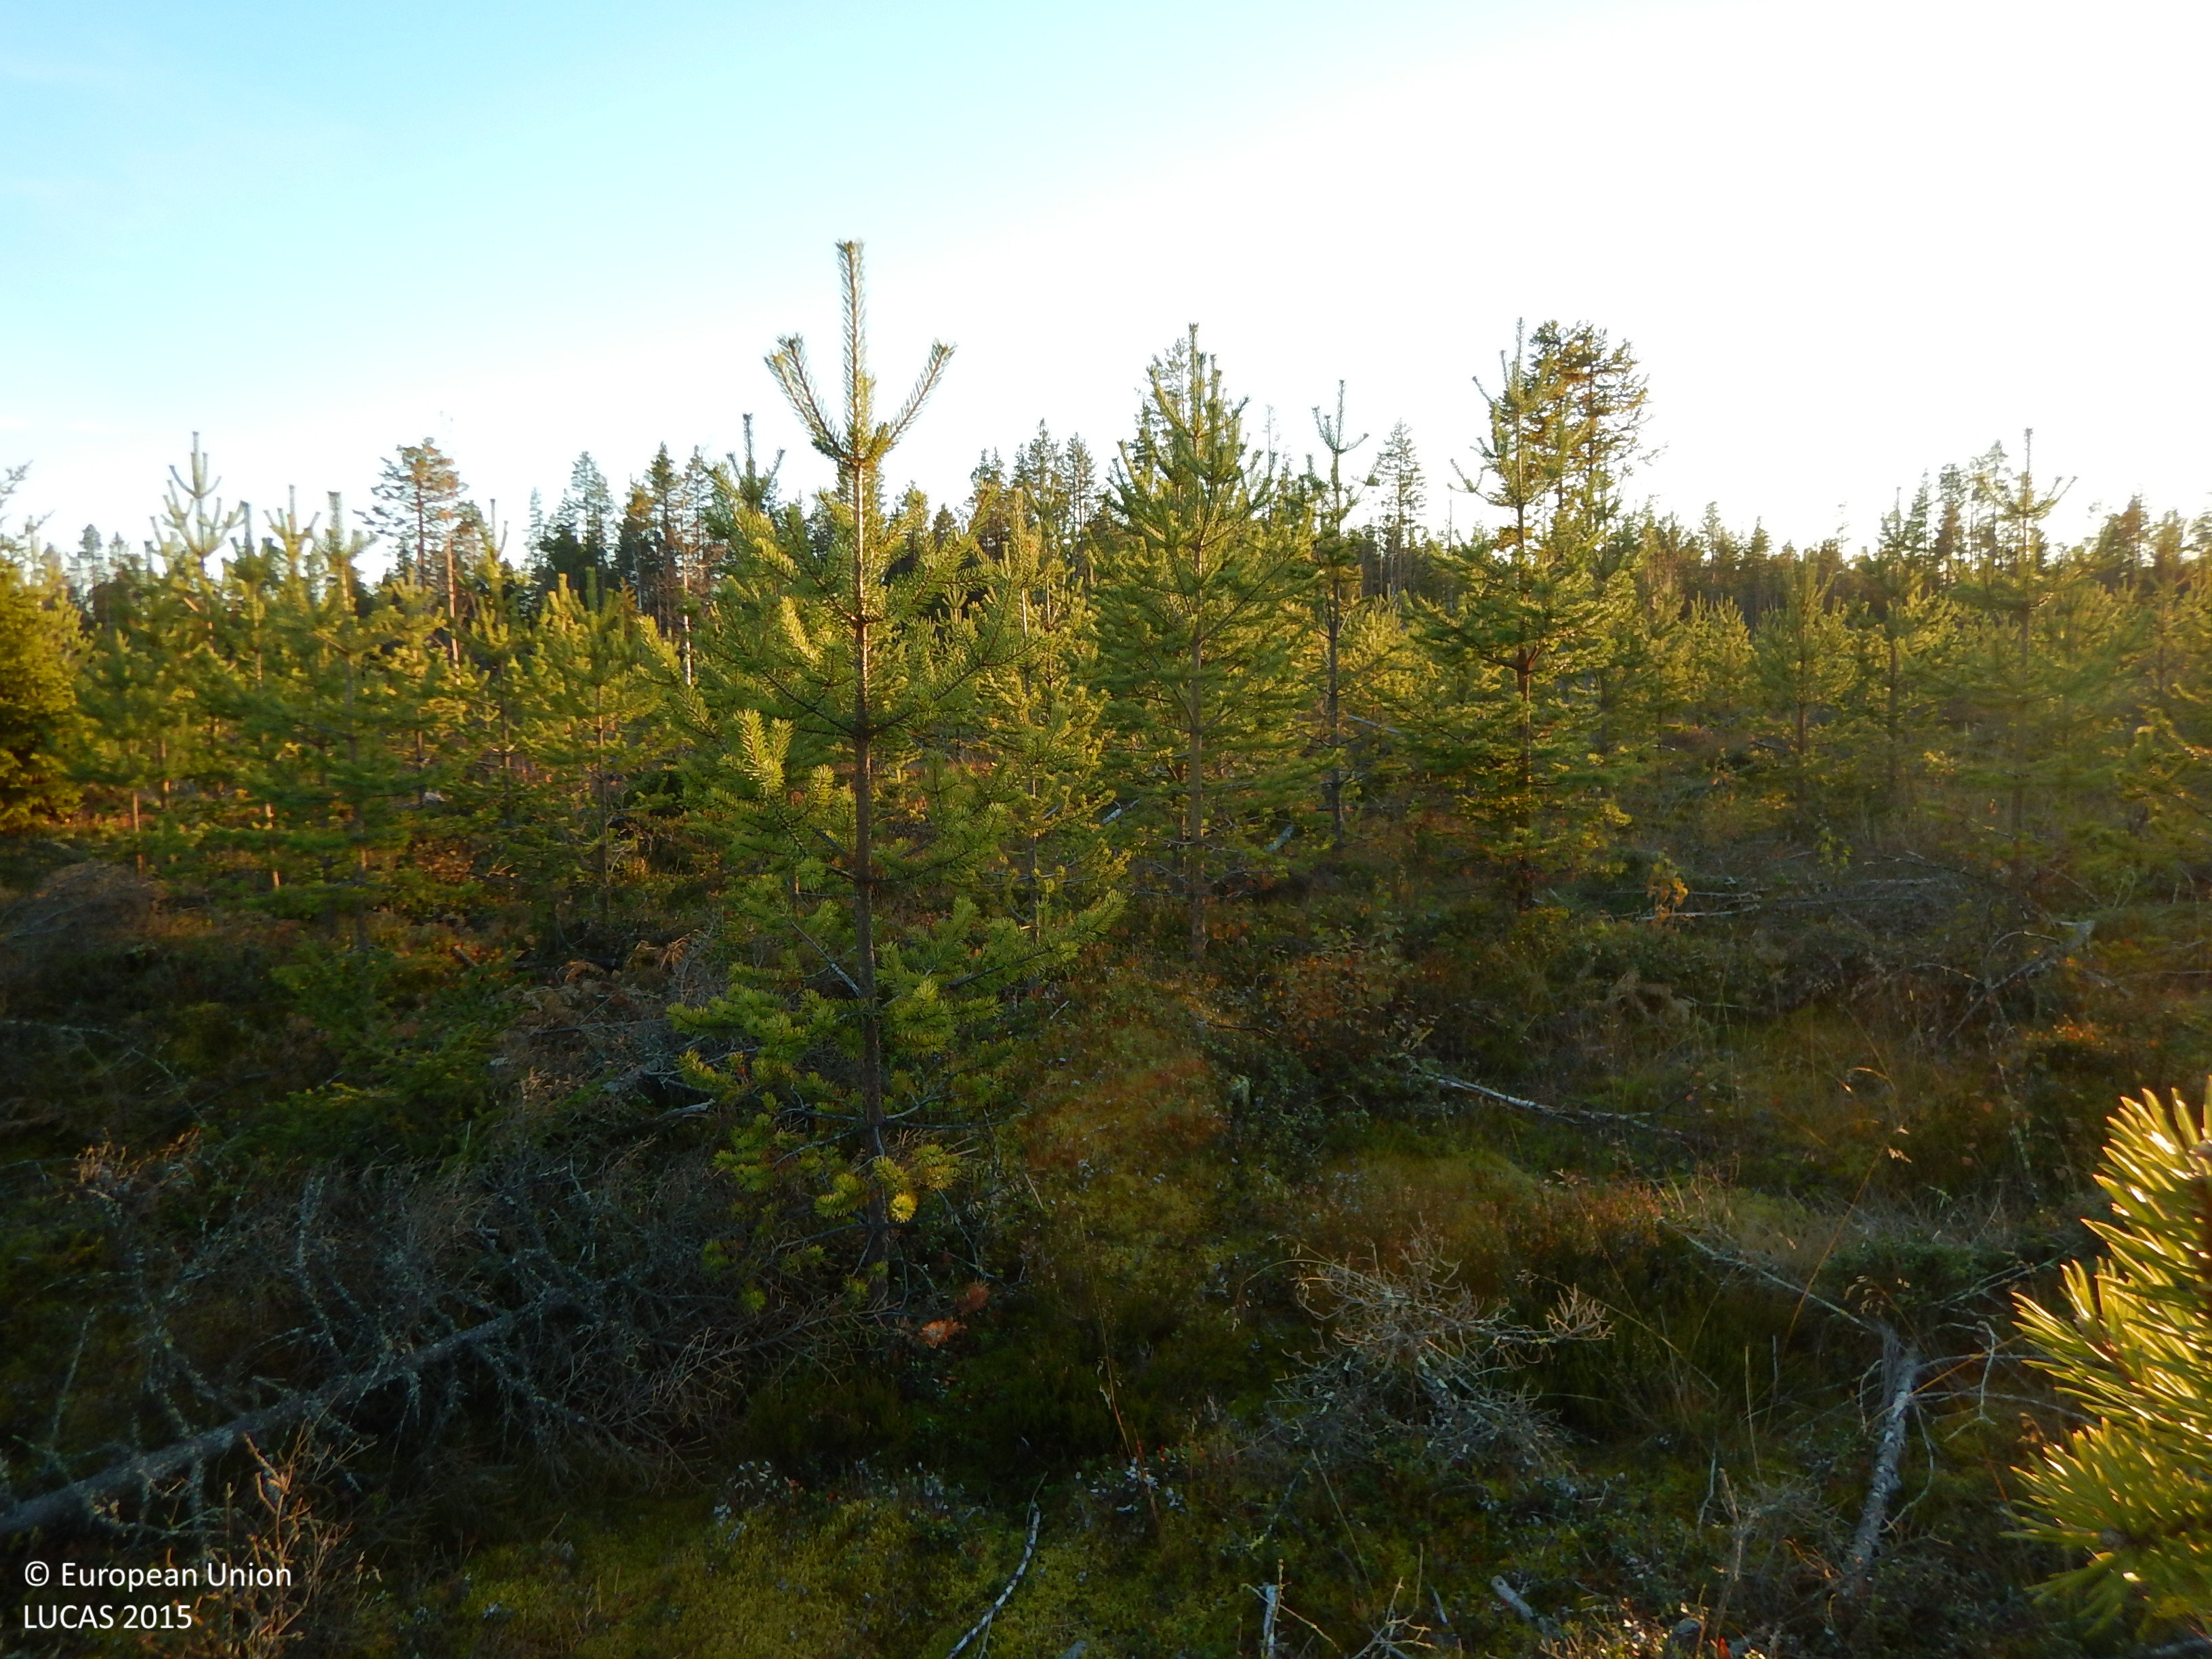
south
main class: Woodland
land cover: Pine dominated coniferous woodland
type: boreal forest
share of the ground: 50 - 75 %
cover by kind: coniferous forest trees 60 %, shrubs 15 %, lichens and mosses 15 %, broadleaved forest trees 5 %, herbaceous plants 5 %
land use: Forestry
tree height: < 5 m
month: October
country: SE
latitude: 65.1209
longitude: 20.8592
